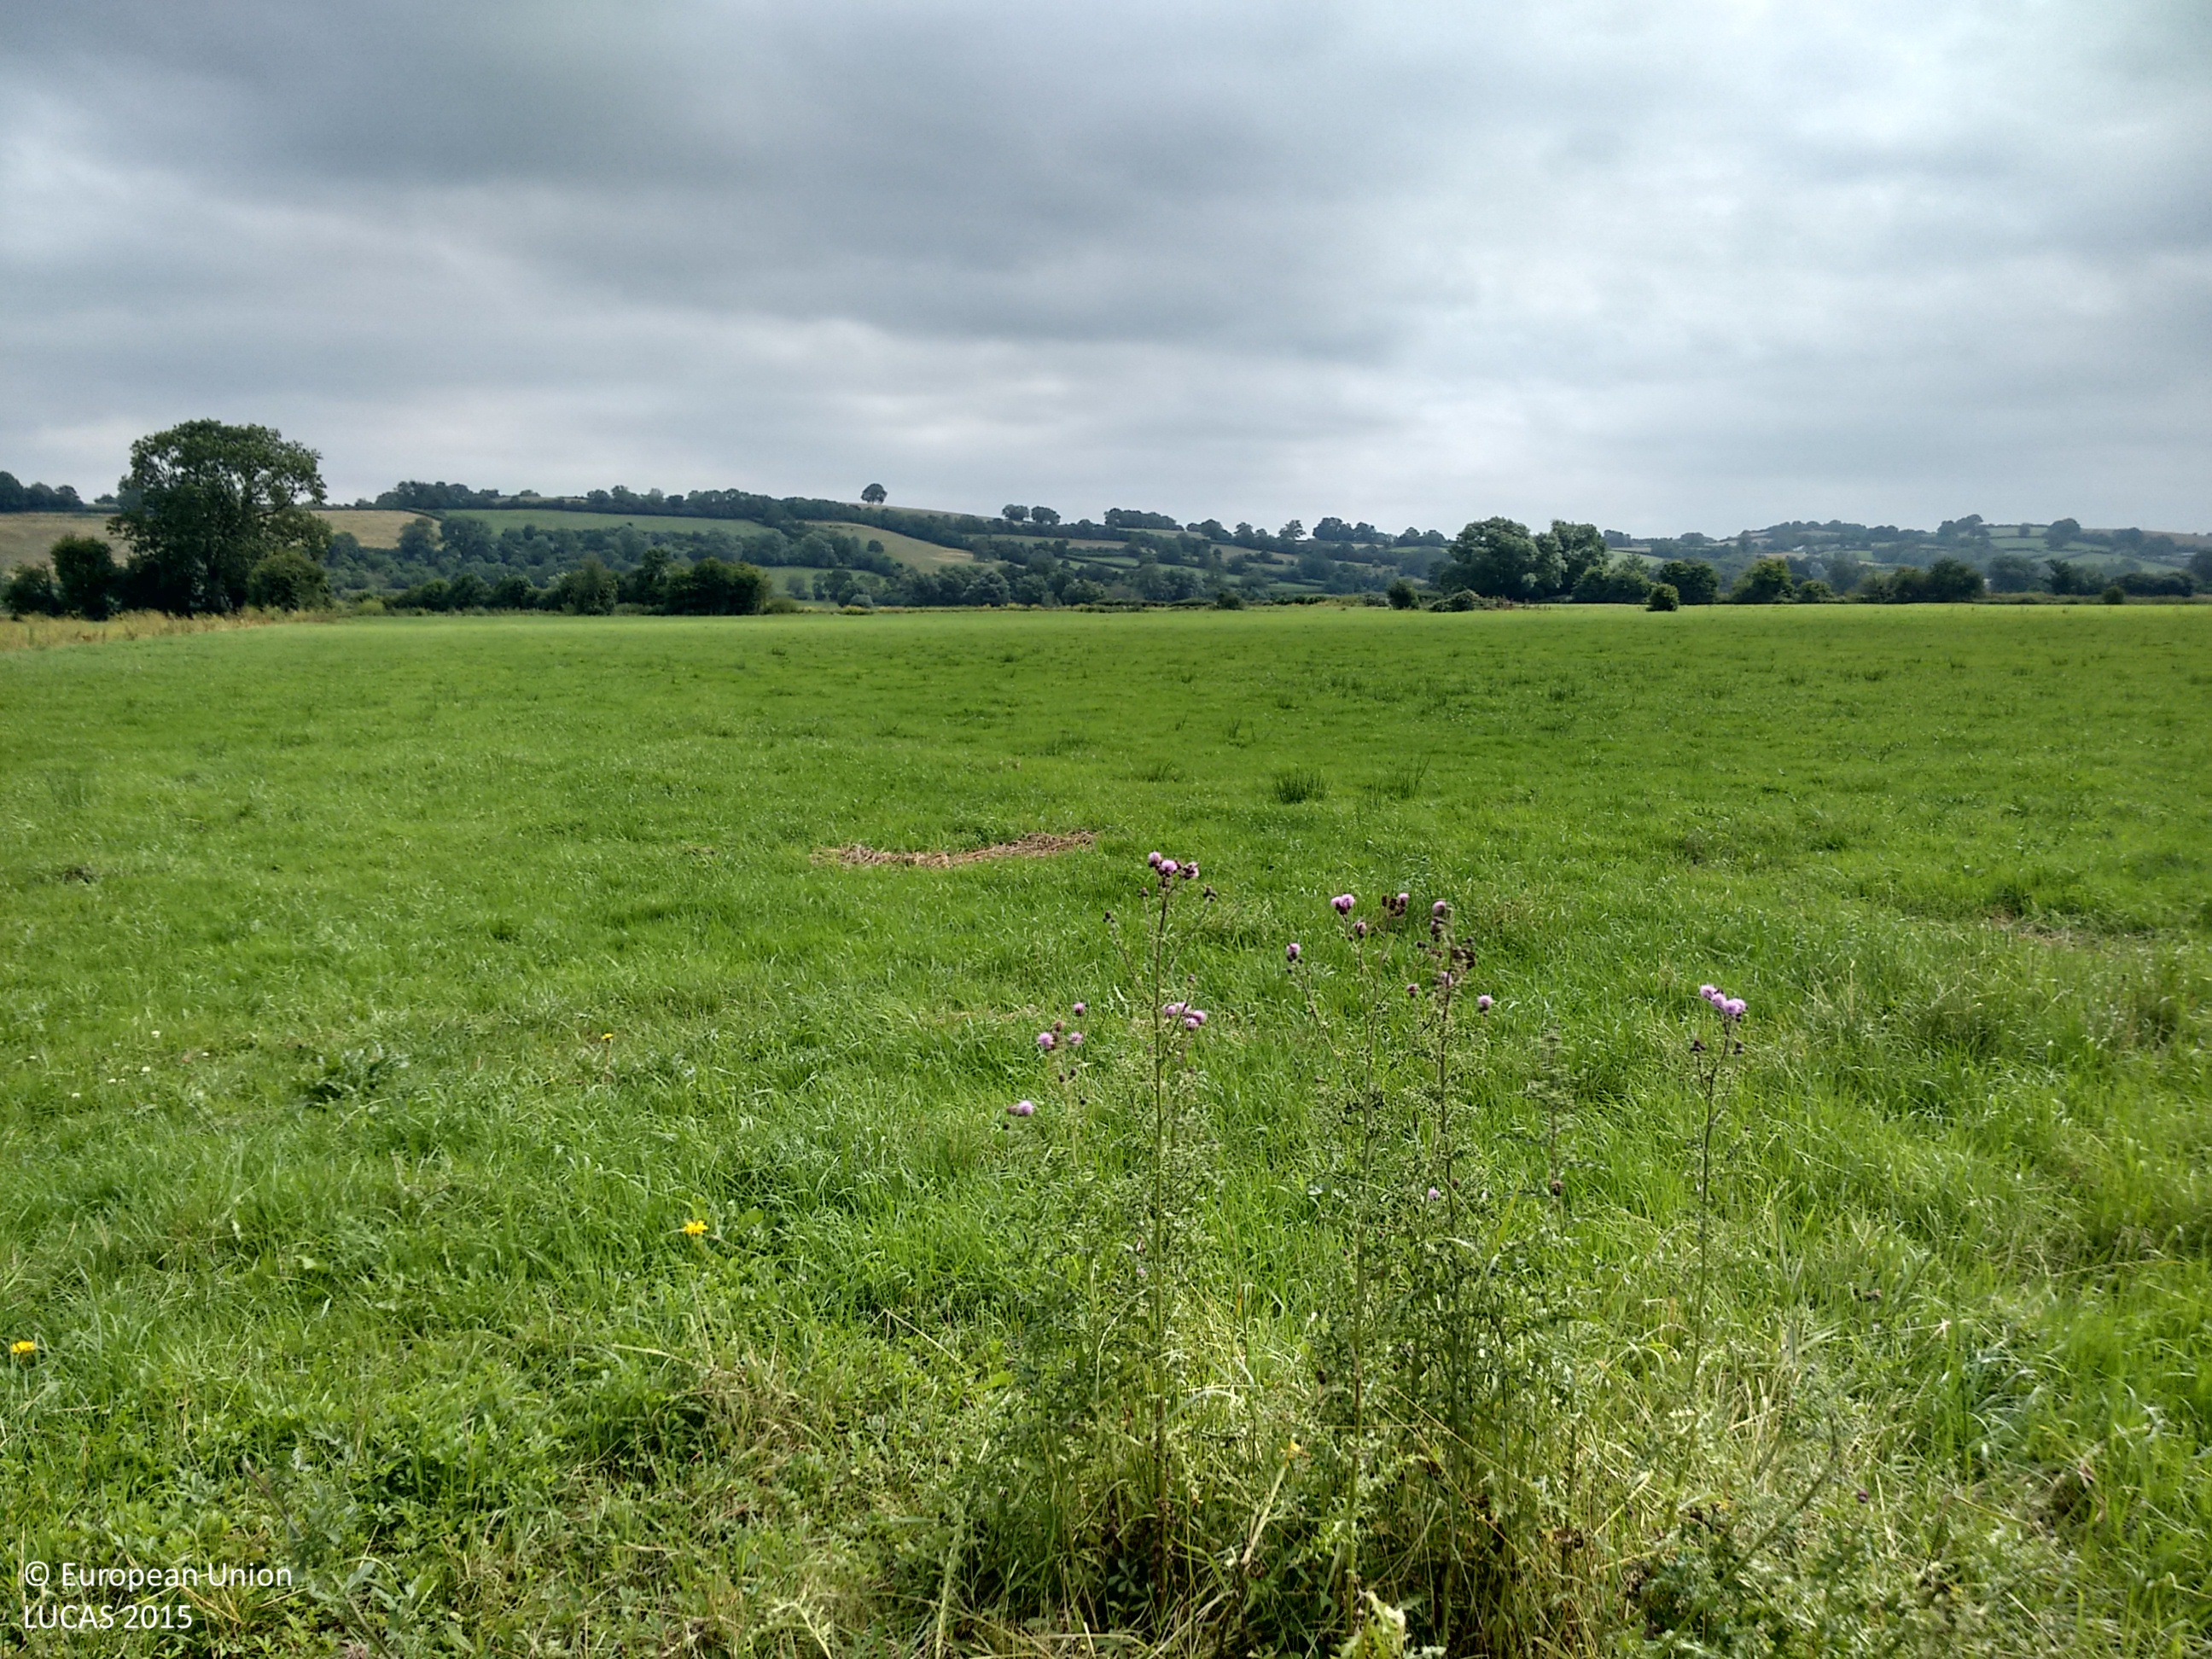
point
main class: Grassland
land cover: Grassland without tree/shrub cover
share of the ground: > 75 %
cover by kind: herbaceous plants 100 %
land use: Agriculture (excluding fallow land and kitchen gardens)
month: July
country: GB
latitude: 51.1964
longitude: -2.7350
